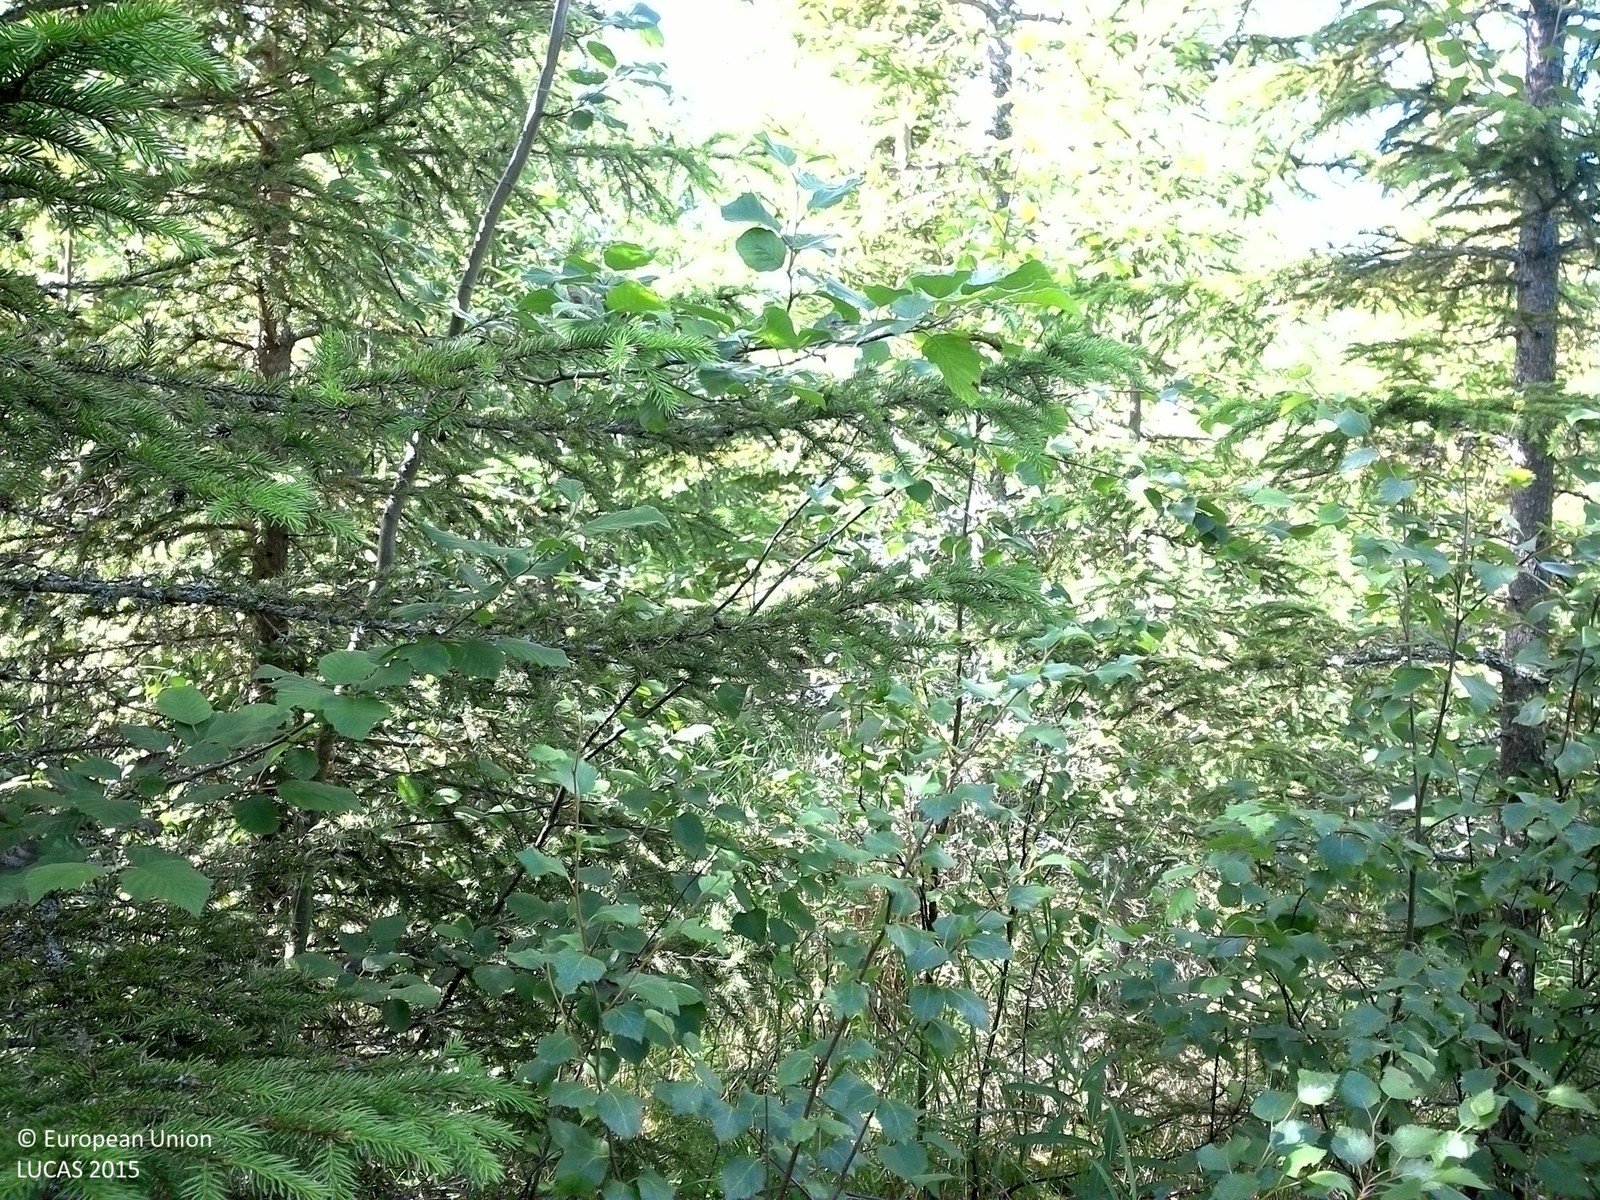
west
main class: Woodland
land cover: Spruce dominated mixed woodland
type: boreal forest
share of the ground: > 75 %
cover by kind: coniferous forest trees 55 %, broadleaved forest trees 30 %, herbaceous plants 10 %, lichens and mosses 5 %
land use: Forestry
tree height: < 5 m
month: August
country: SE
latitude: 62.8659
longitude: 16.6005
